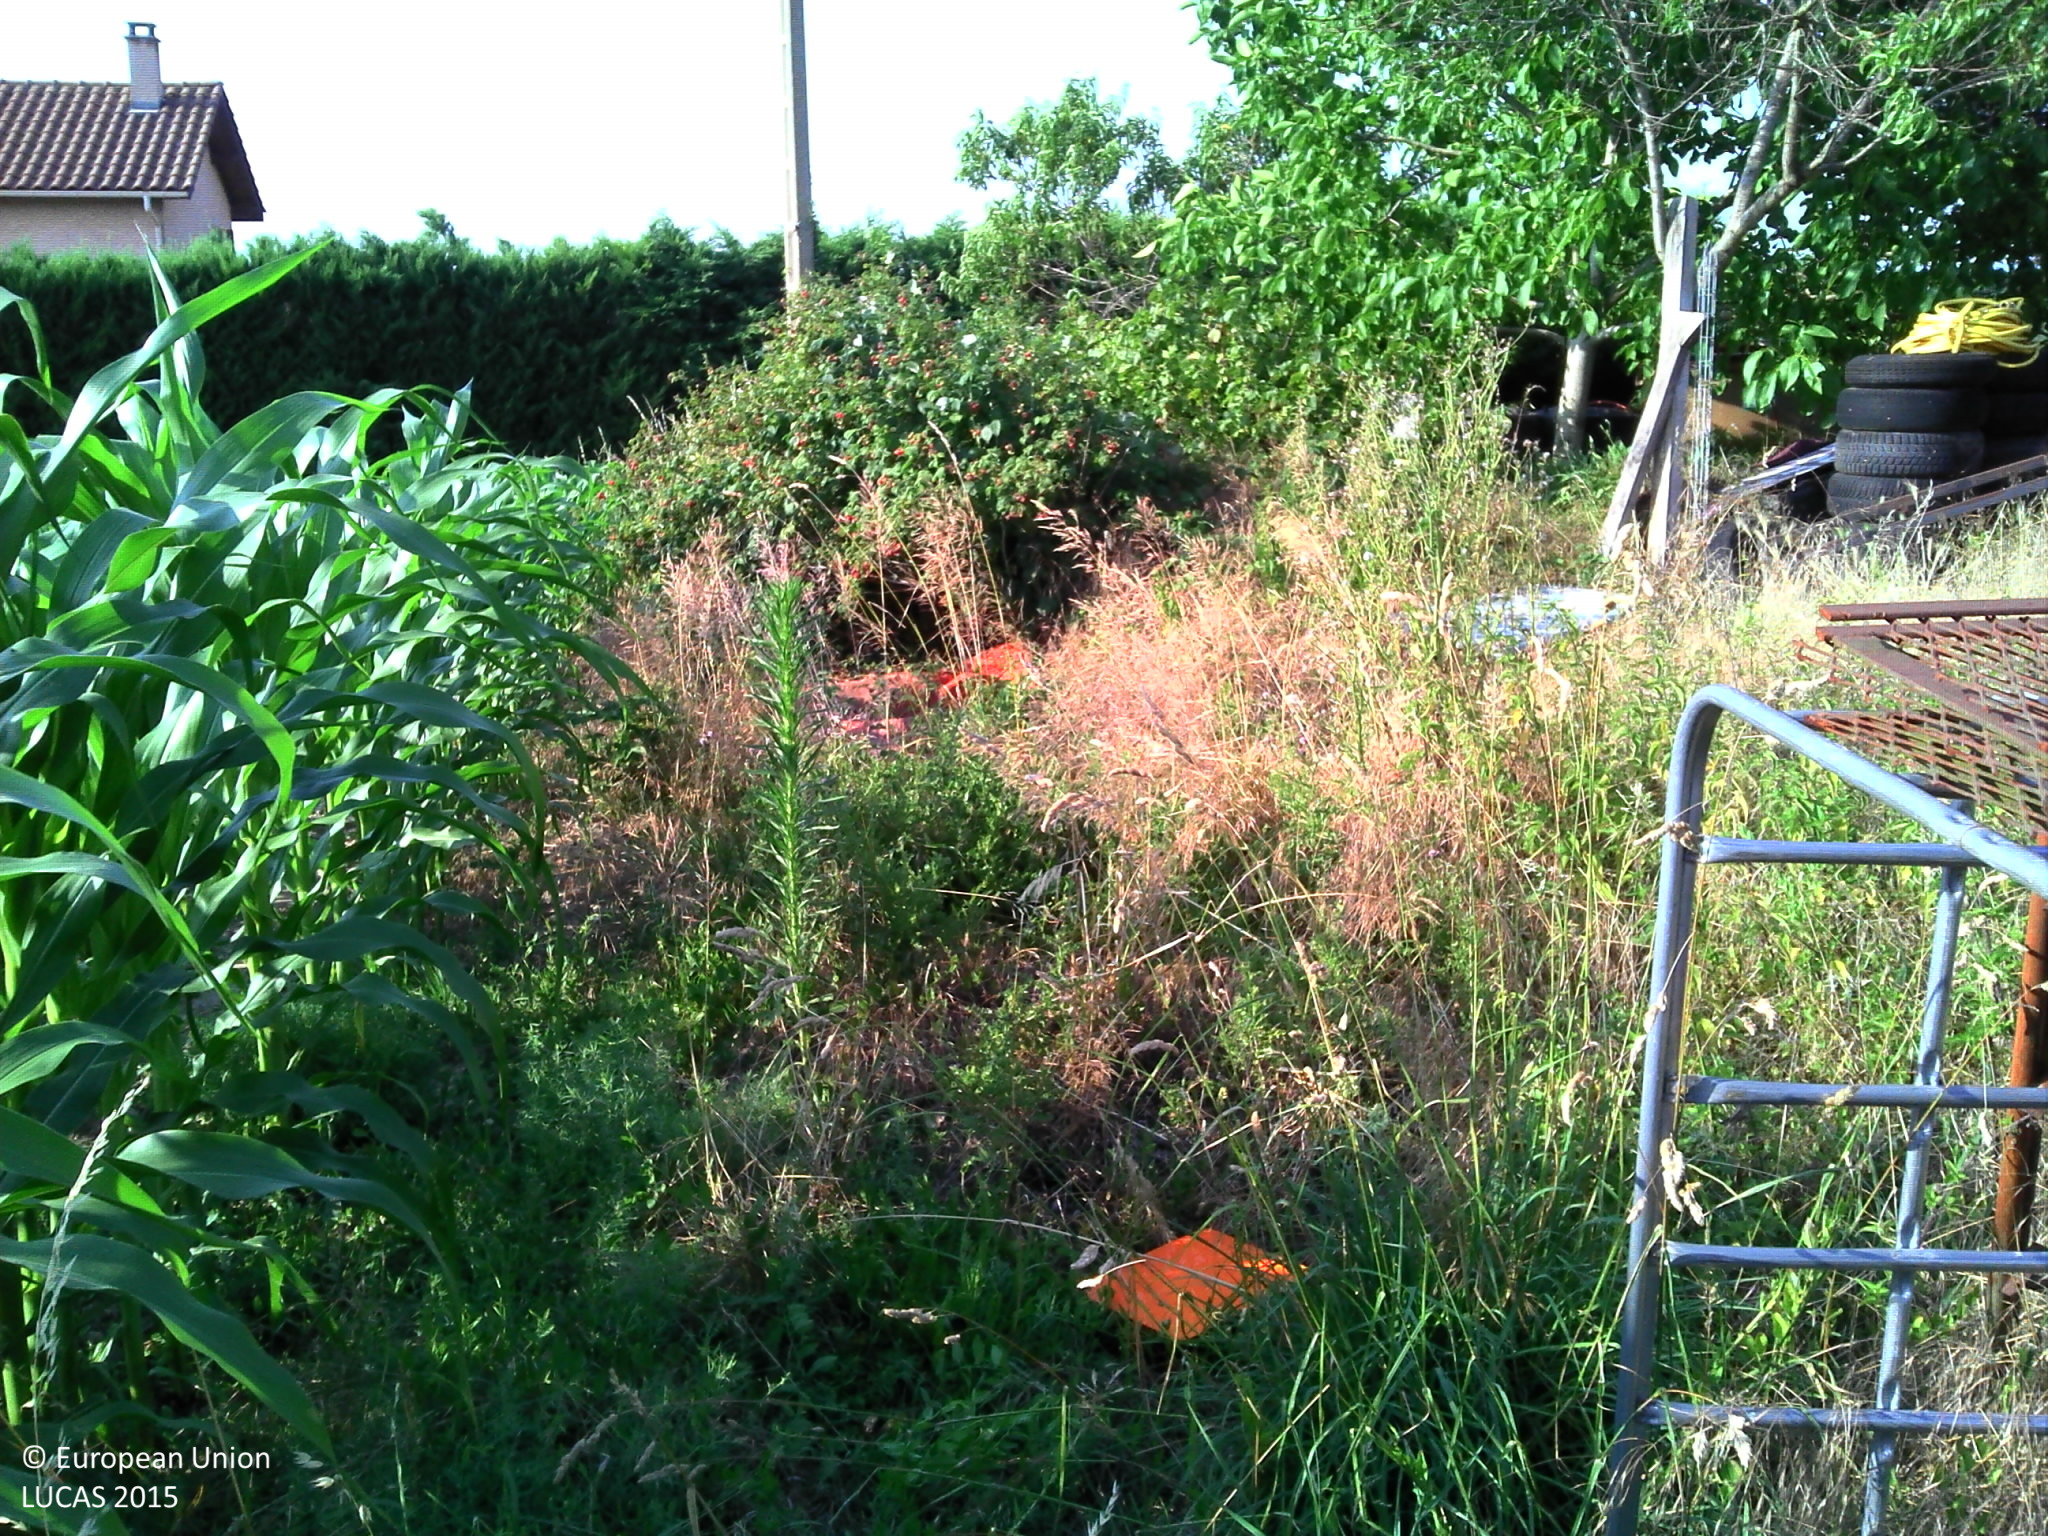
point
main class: Grassland
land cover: Grassland with sparse tree/shrub cover
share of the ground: > 75 %
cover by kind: herbaceous plants 70 %, consolidated bare surface 15 %, shrubs 10 %, broadleaved forest trees 5 %
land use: Residential
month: July
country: FR
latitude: 45.6005
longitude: 5.3505
